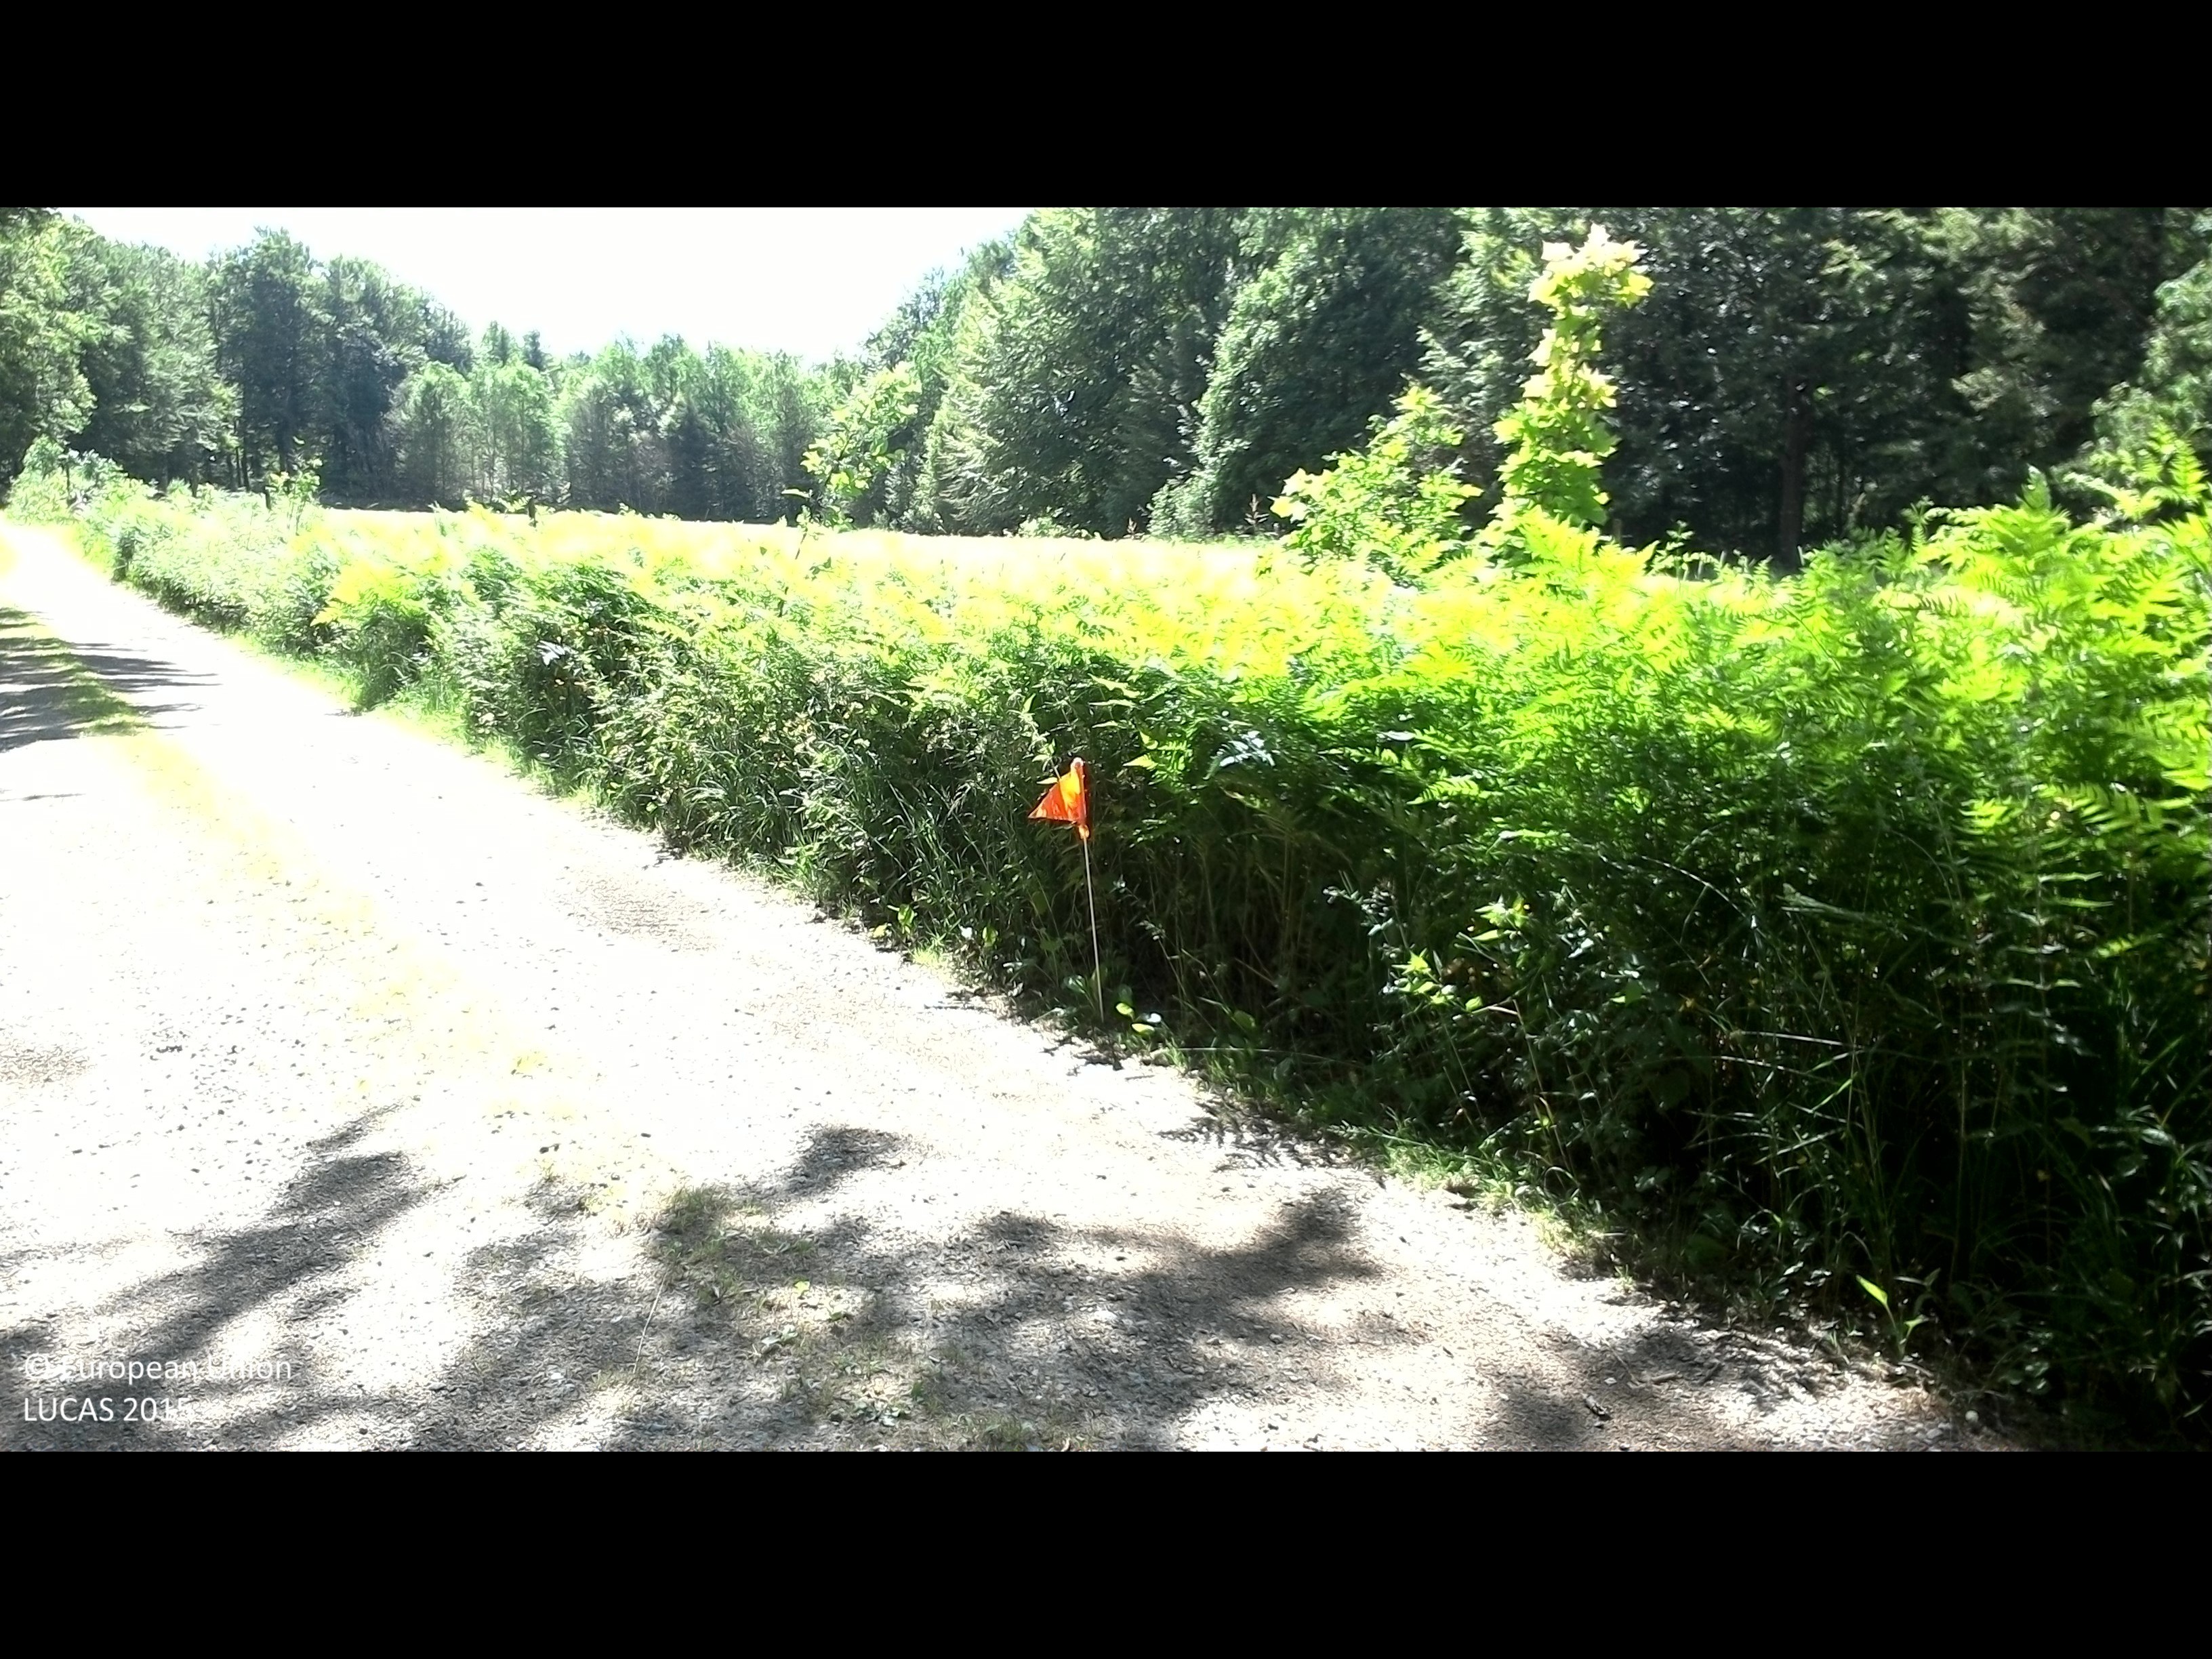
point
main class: Woodland
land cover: Broadleaved woodland
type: beech forest
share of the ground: > 75 %
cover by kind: broadleaved forest trees 75 %, herbaceous plants 20 %, shrubs 5 %
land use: Forestry
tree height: > 5 m
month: July
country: SE
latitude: 56.3709
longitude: 15.1958
